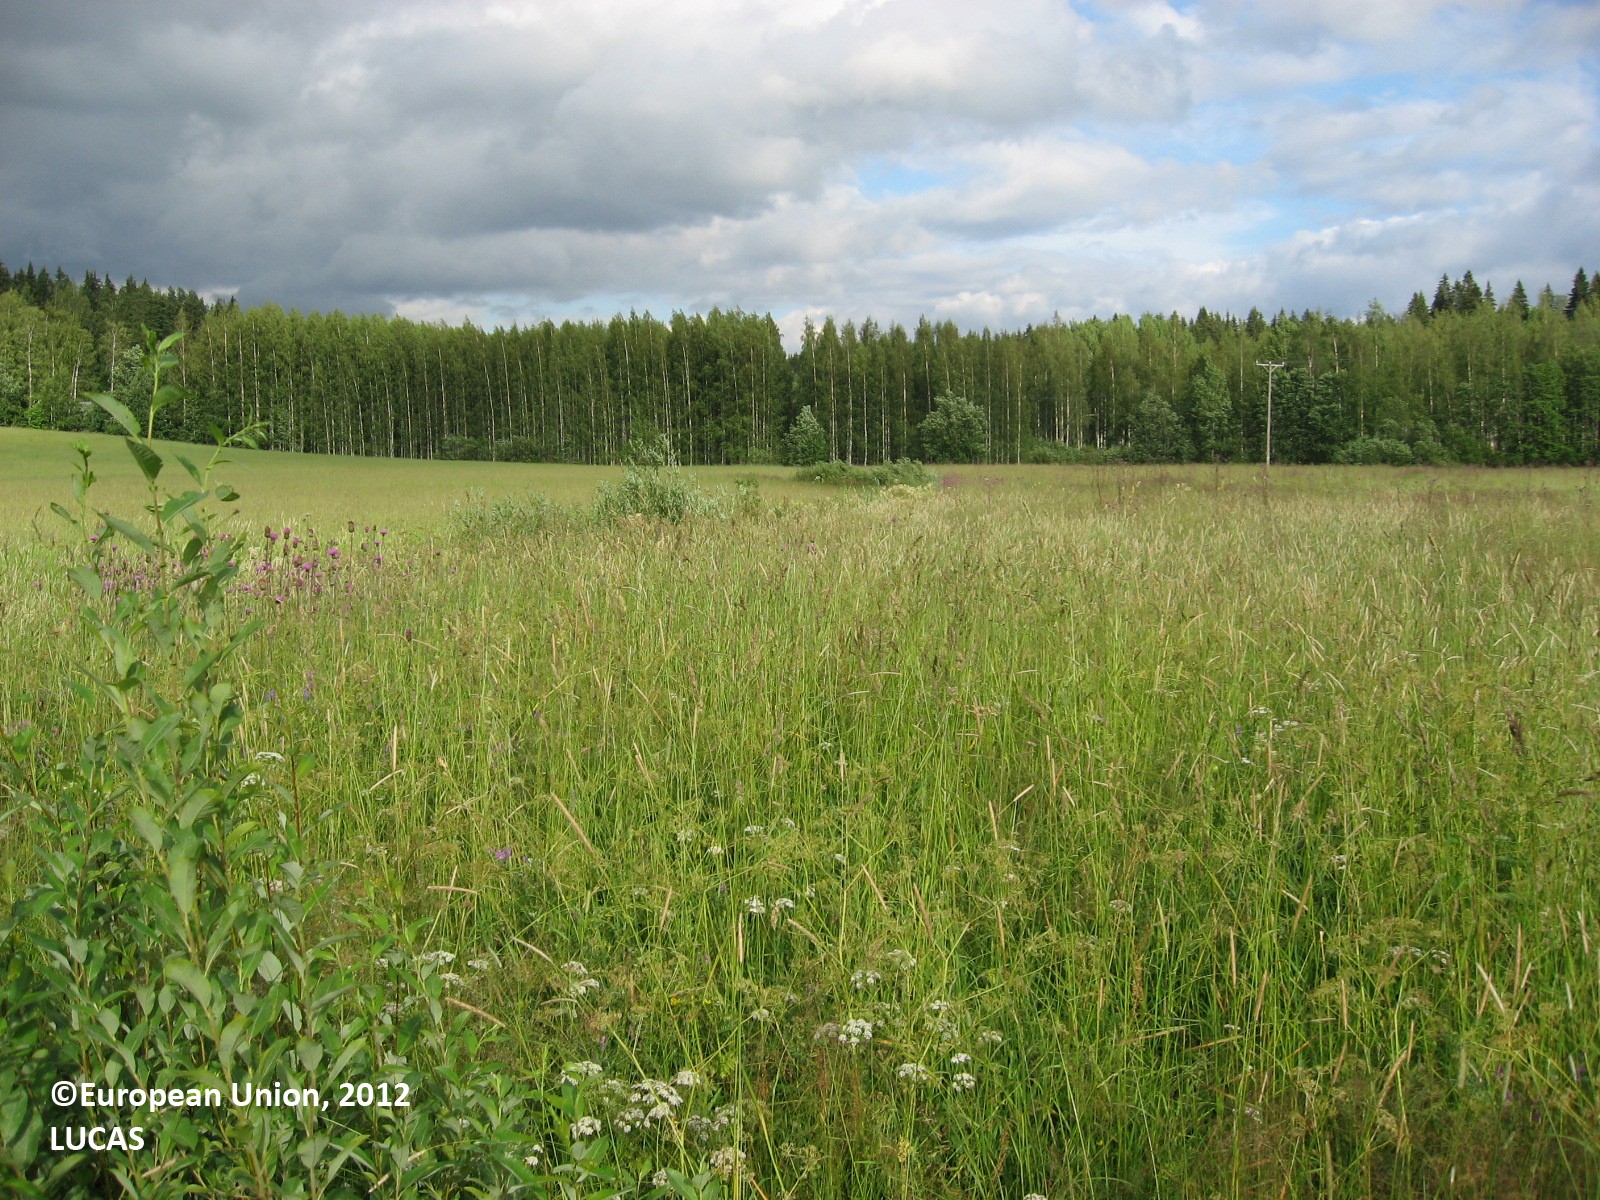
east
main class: Cropland
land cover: Temporary grasslands
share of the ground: > 75 %
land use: Agriculture (excluding fallow land and kitchen gardens)
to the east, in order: Temporary grasslands; Grass margins; Ditches and canals; Grass margins; Ditches and canals; Grass margins; Temporary grasslands; Grass margins; Ditches and canals; Grass margins; Temporary grasslands; Grass margins; Ditches and canals; Grass margins; Broadleaved woodland; Electric lines; Broadleaved woodland
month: July
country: FI
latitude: 61.0039
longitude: 25.7206
